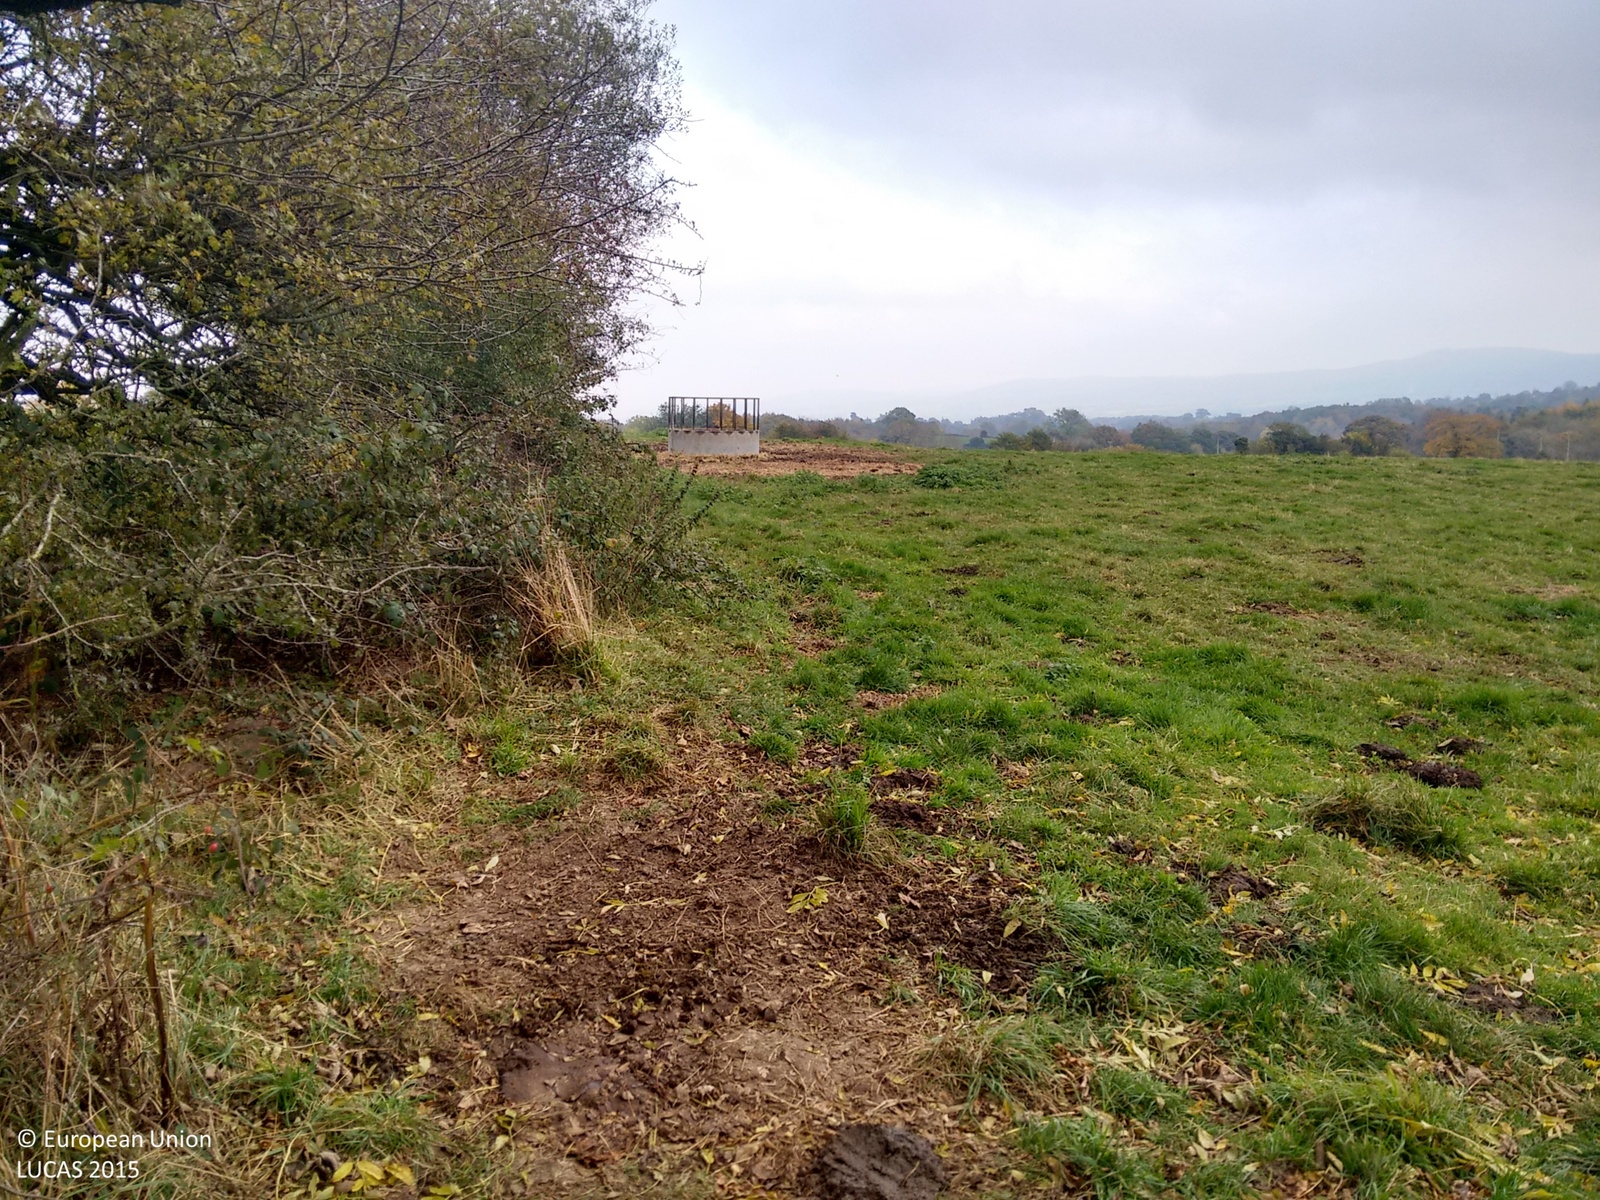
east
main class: Grassland
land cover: Grassland without tree/shrub cover
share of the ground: > 75 %
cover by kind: herbaceous plants 100 %
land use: Agriculture (excluding fallow land and kitchen gardens)
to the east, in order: Grassland without tree/shrub cover; Fences; Grassland without tree/shrub cover; Abandoned hedges; Fences; Grassland without tree/shrub cover
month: October
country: GB
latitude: 52.5873
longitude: -2.8395
